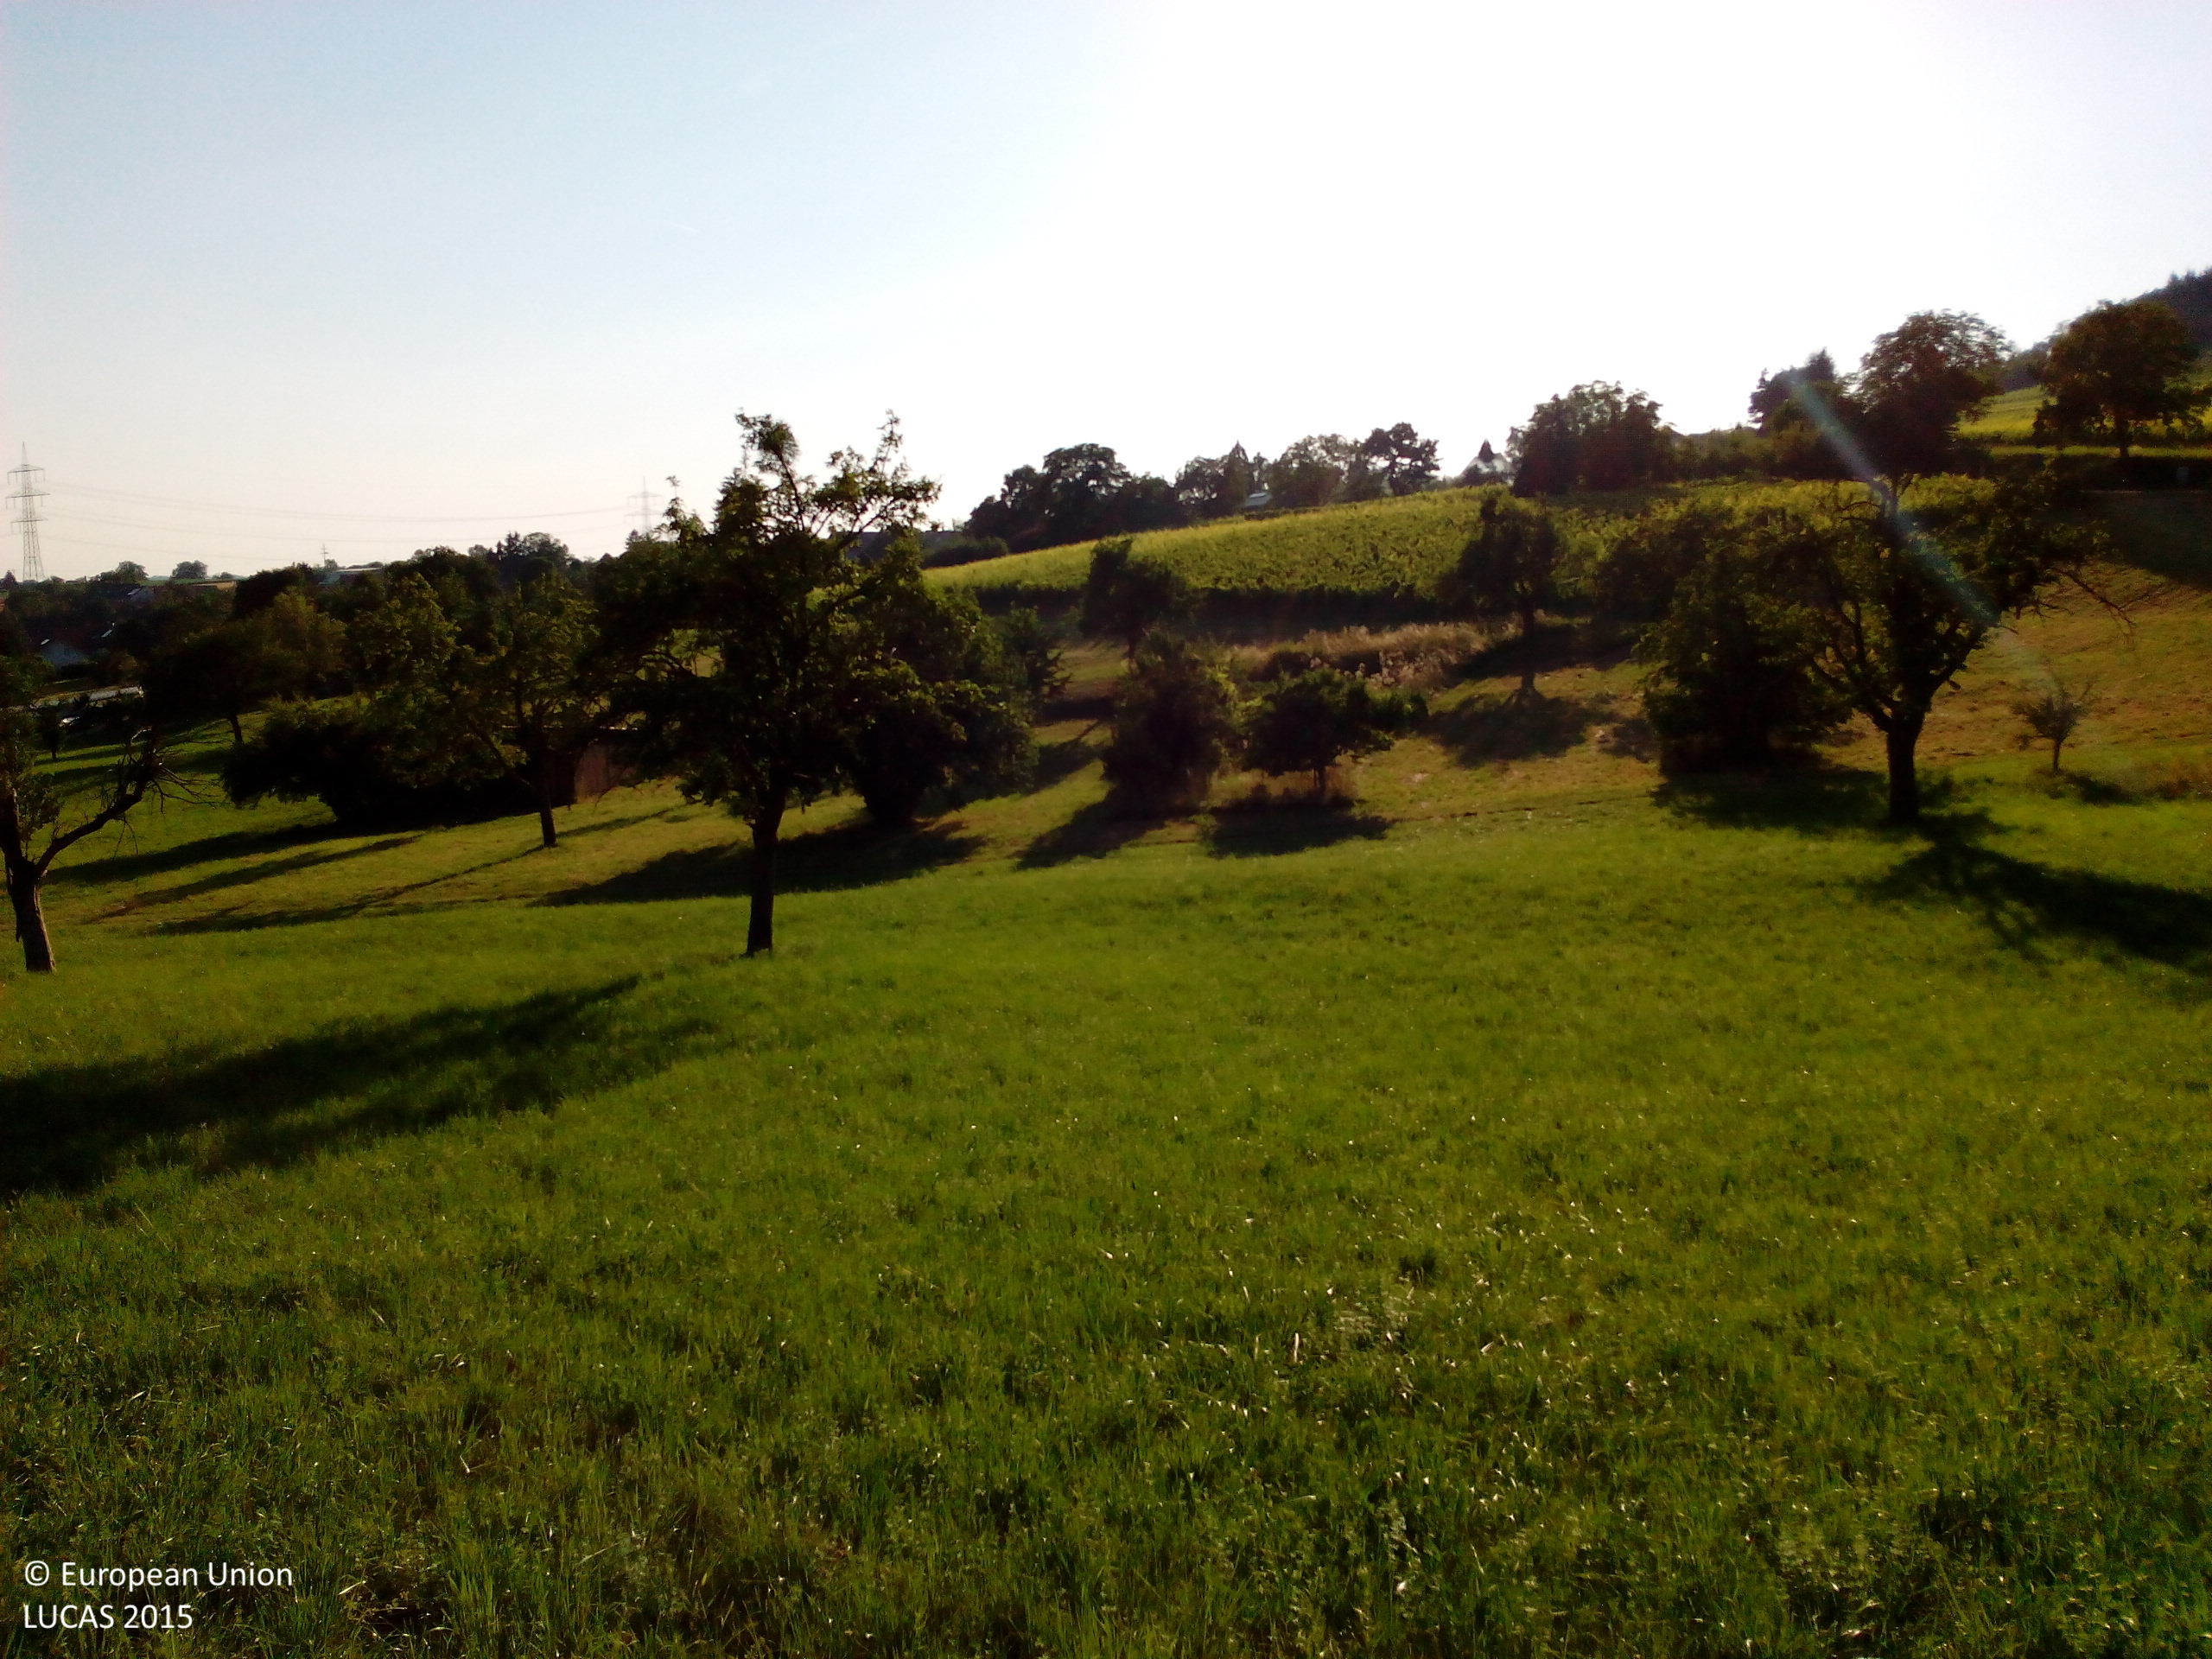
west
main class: Cropland
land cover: Other fruit trees and berries
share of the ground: < 10 %
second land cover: Grassland without tree/shrub cover
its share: > 75 %
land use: Agriculture (excluding fallow land and kitchen gardens)
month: July
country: DE
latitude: 47.7116
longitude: 7.6156
